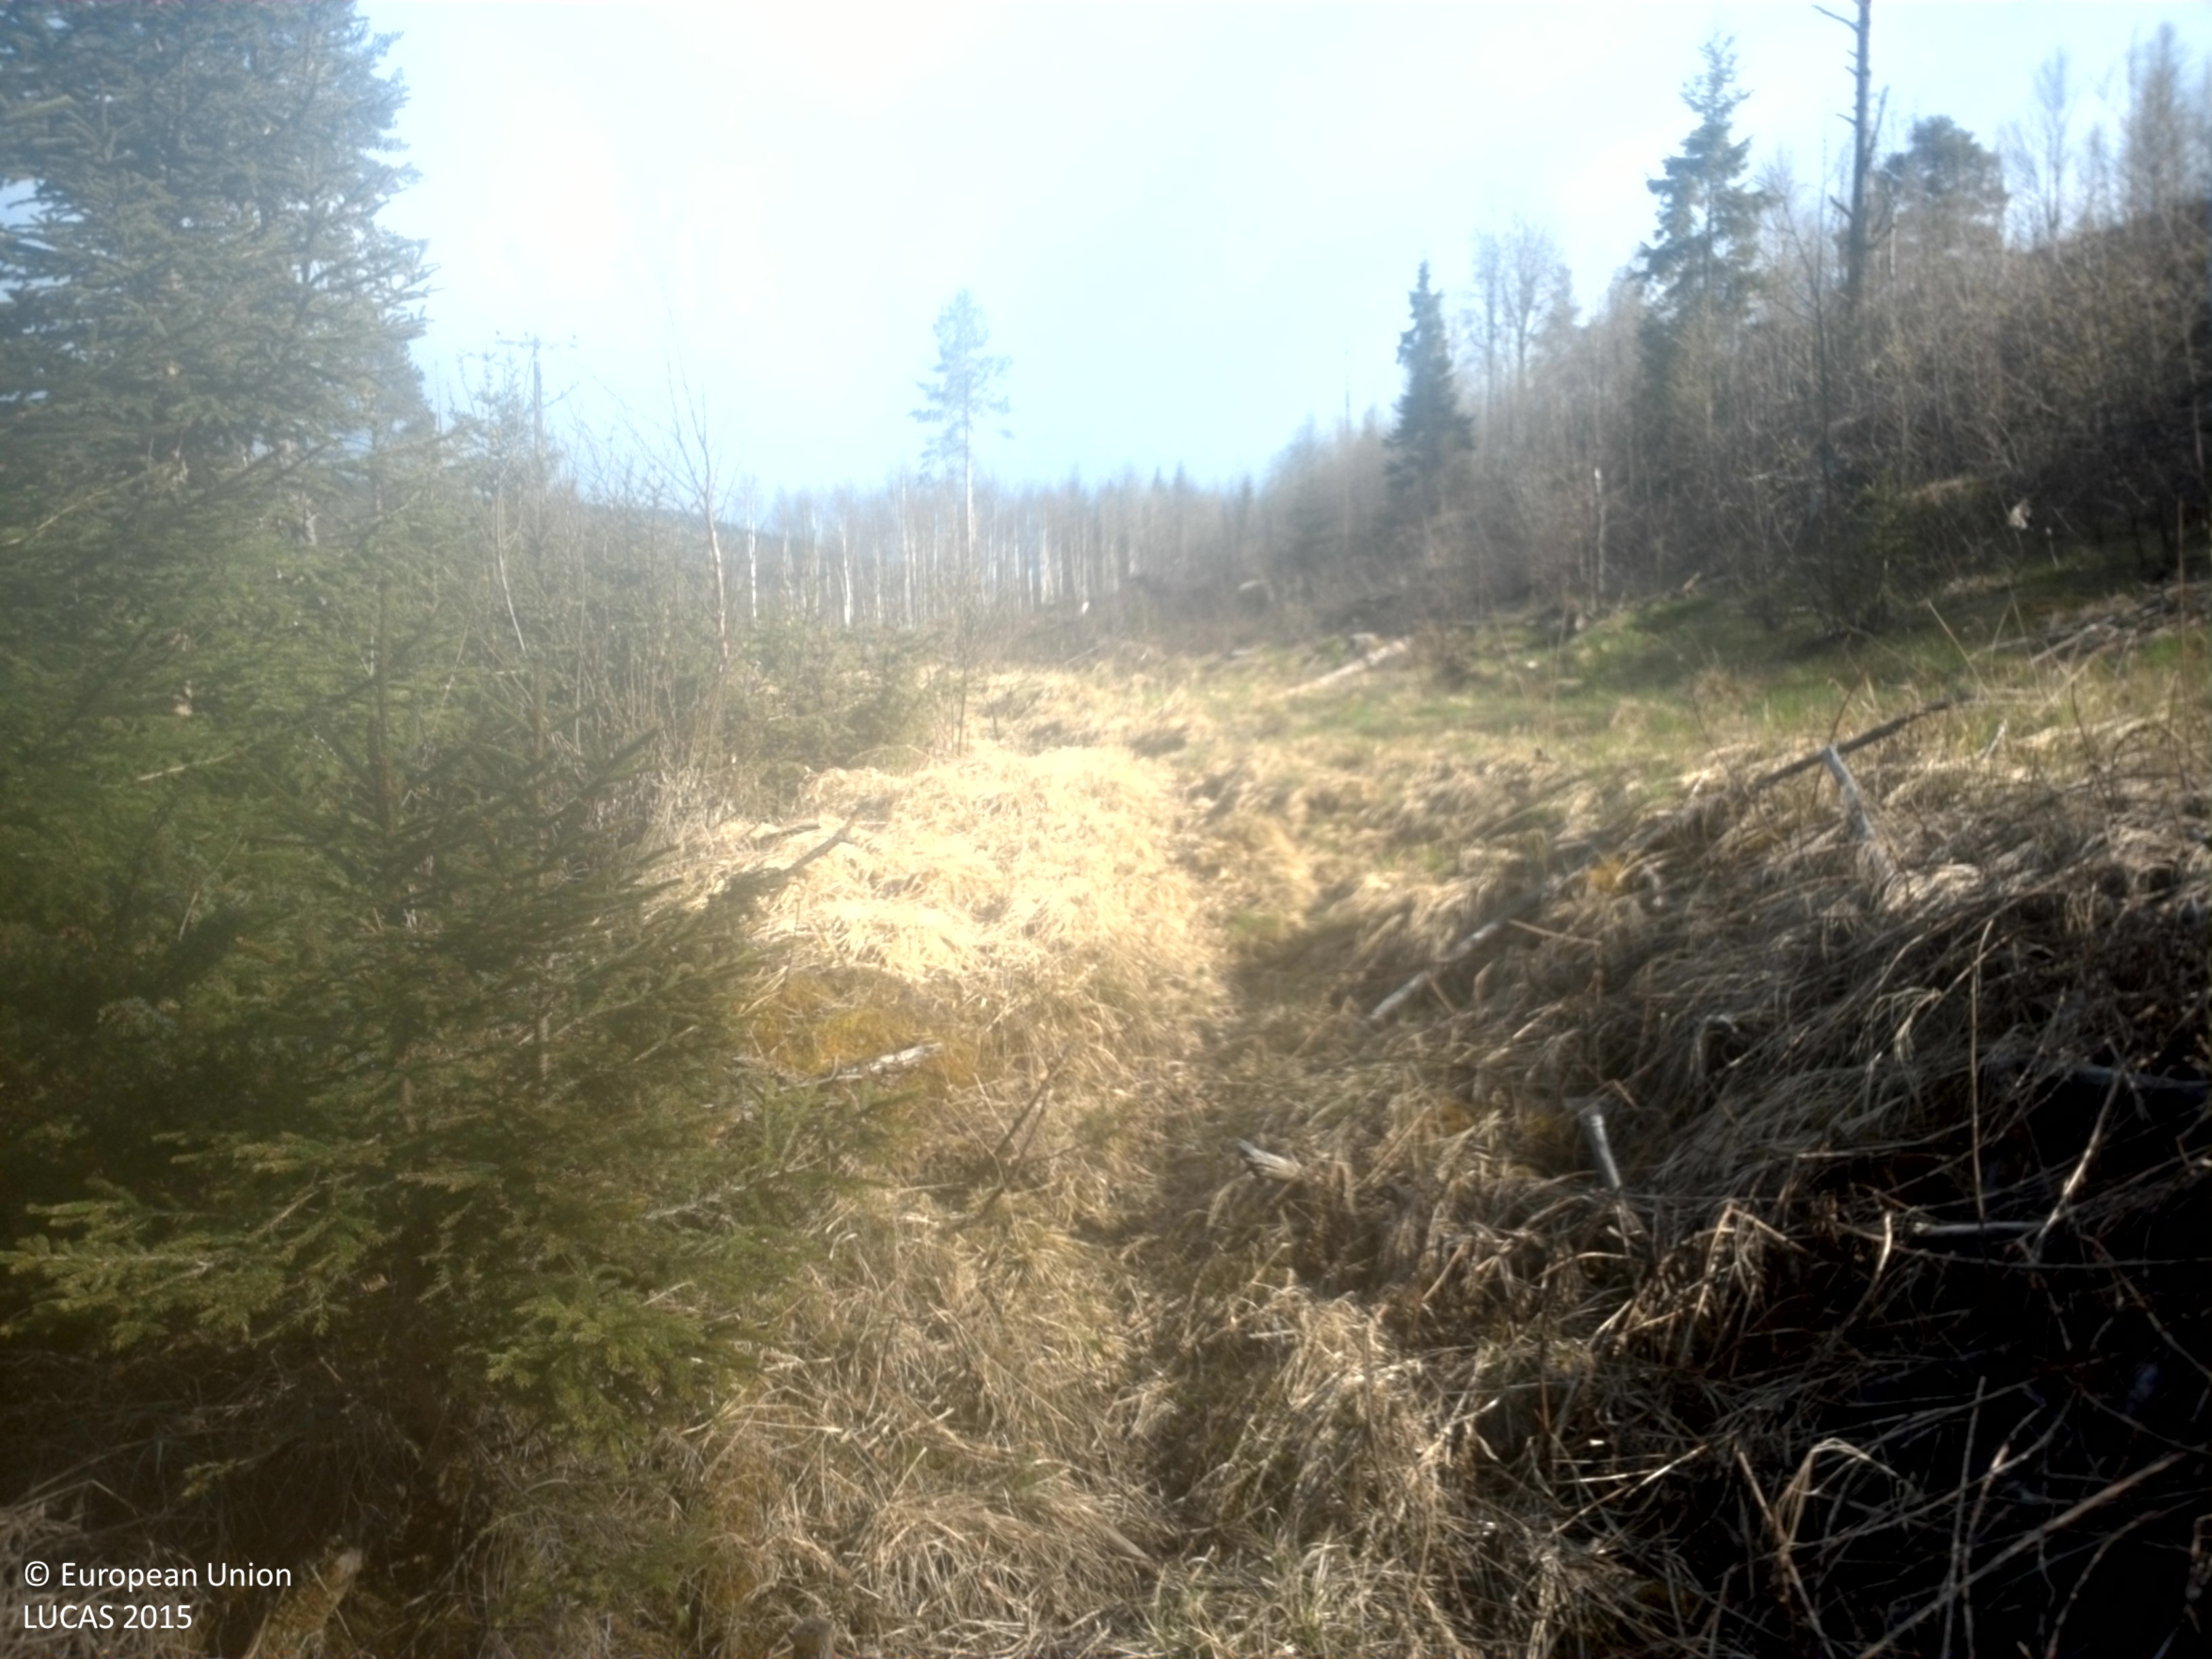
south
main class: Grassland
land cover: Spontaneously vegetated surfaces
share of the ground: > 75 %
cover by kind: herbaceous plants 95 %, shrubs 5 %
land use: Semi-natural and natural areas not in use
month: May
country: SE
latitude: 60.9703
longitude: 13.3327
